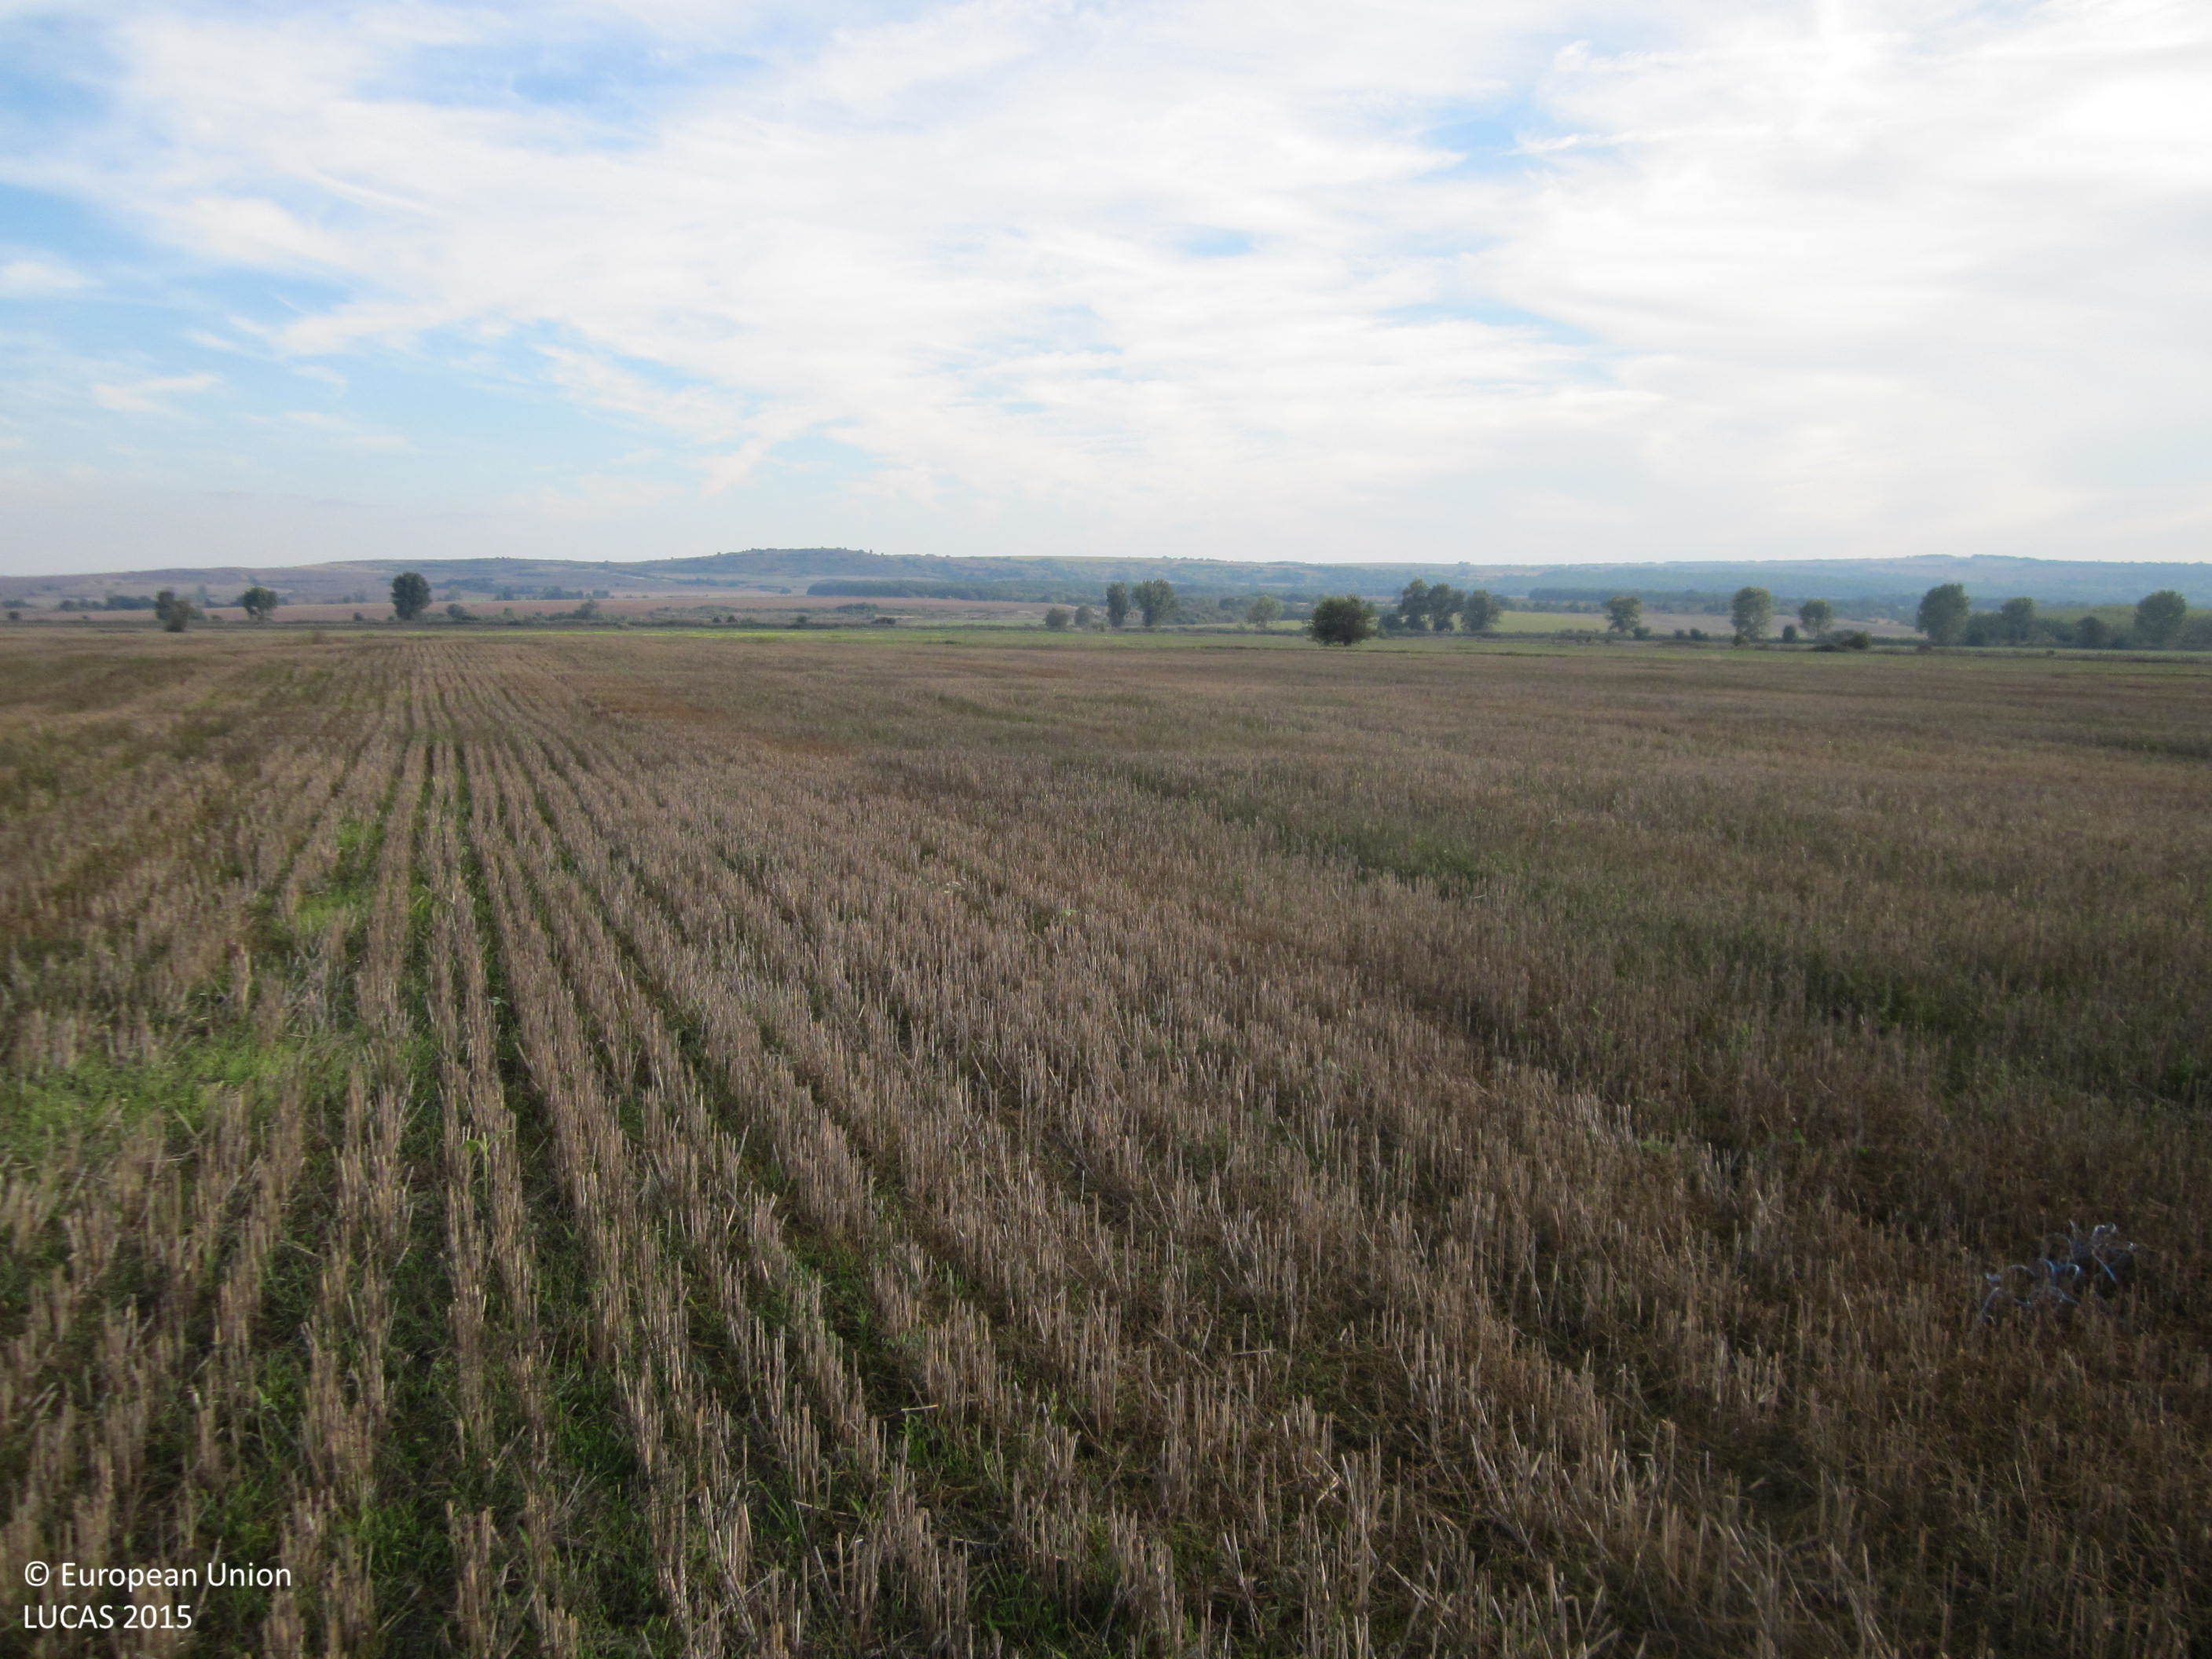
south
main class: Cropland
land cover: Common wheat
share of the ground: 50 - 75 %
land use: Agriculture (excluding fallow land and kitchen gardens)
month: October
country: BG
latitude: 42.7475
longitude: 26.8033
